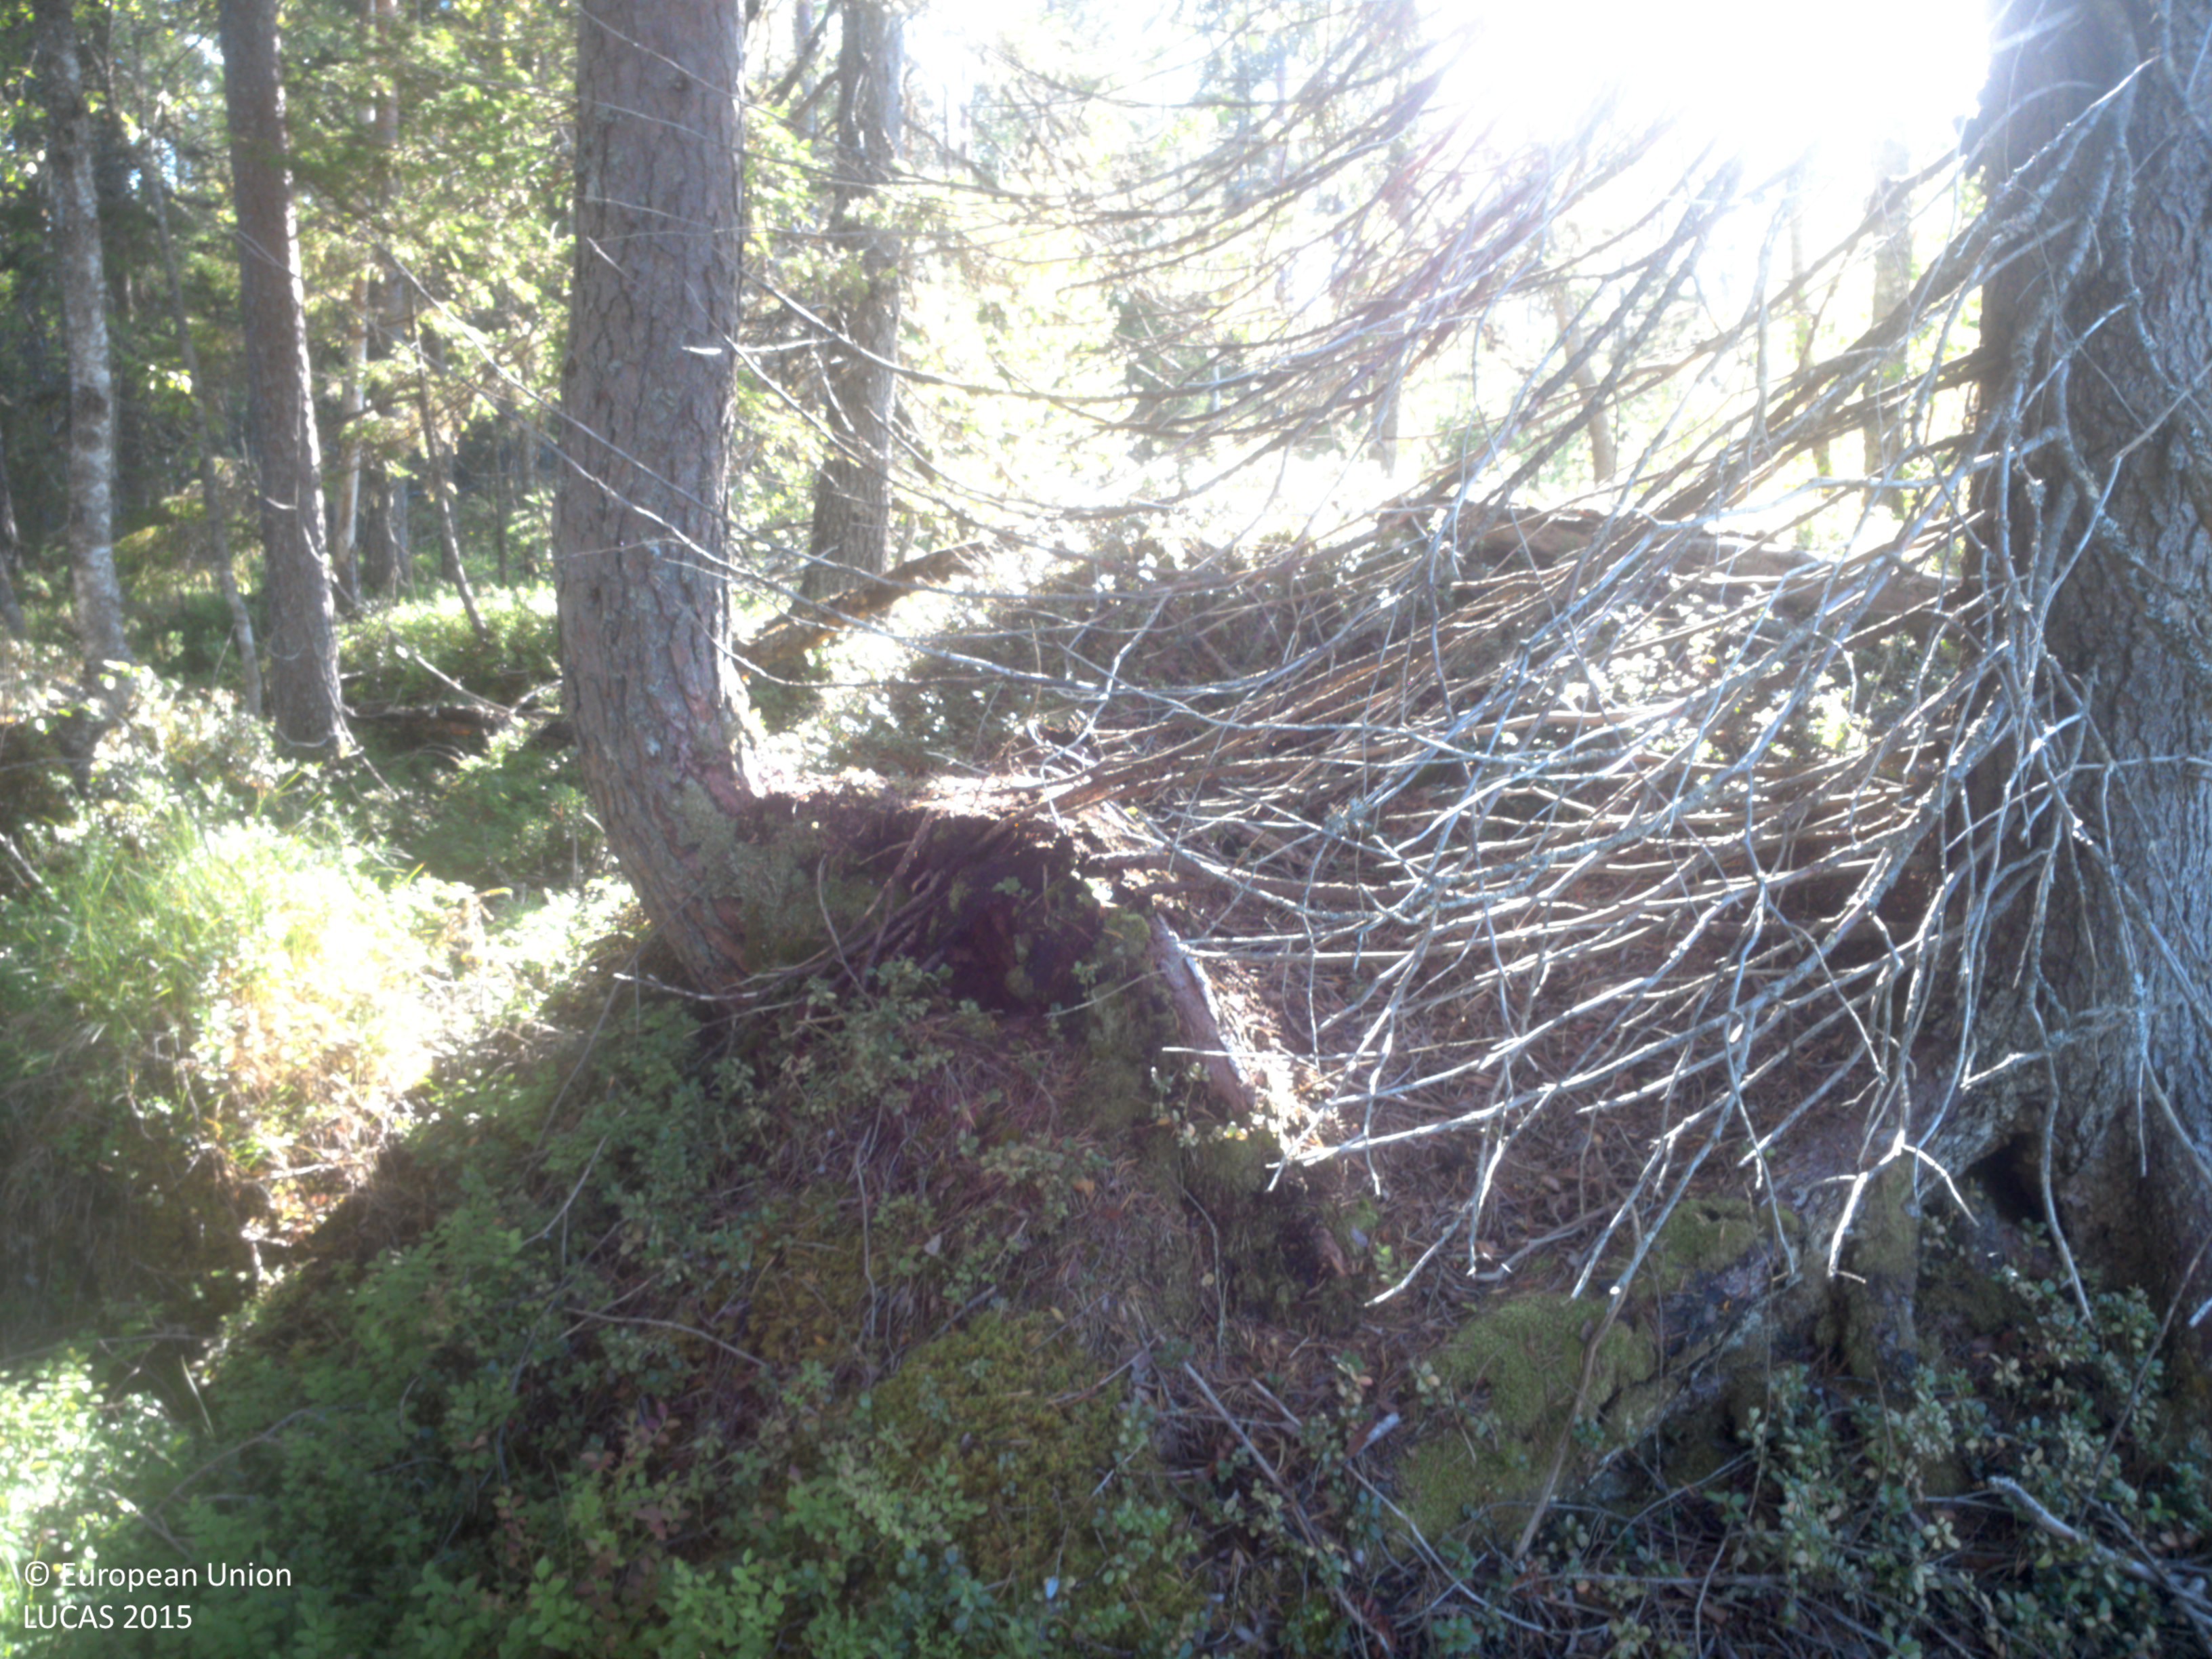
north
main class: Woodland
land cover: Other coniferous woodland
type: boreal forest
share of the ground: 50 - 75 %
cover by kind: coniferous forest trees 50 %, shrubs 50 %
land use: Forestry
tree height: > 5 m
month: August
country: SE
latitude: 63.7886
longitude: 20.0255
